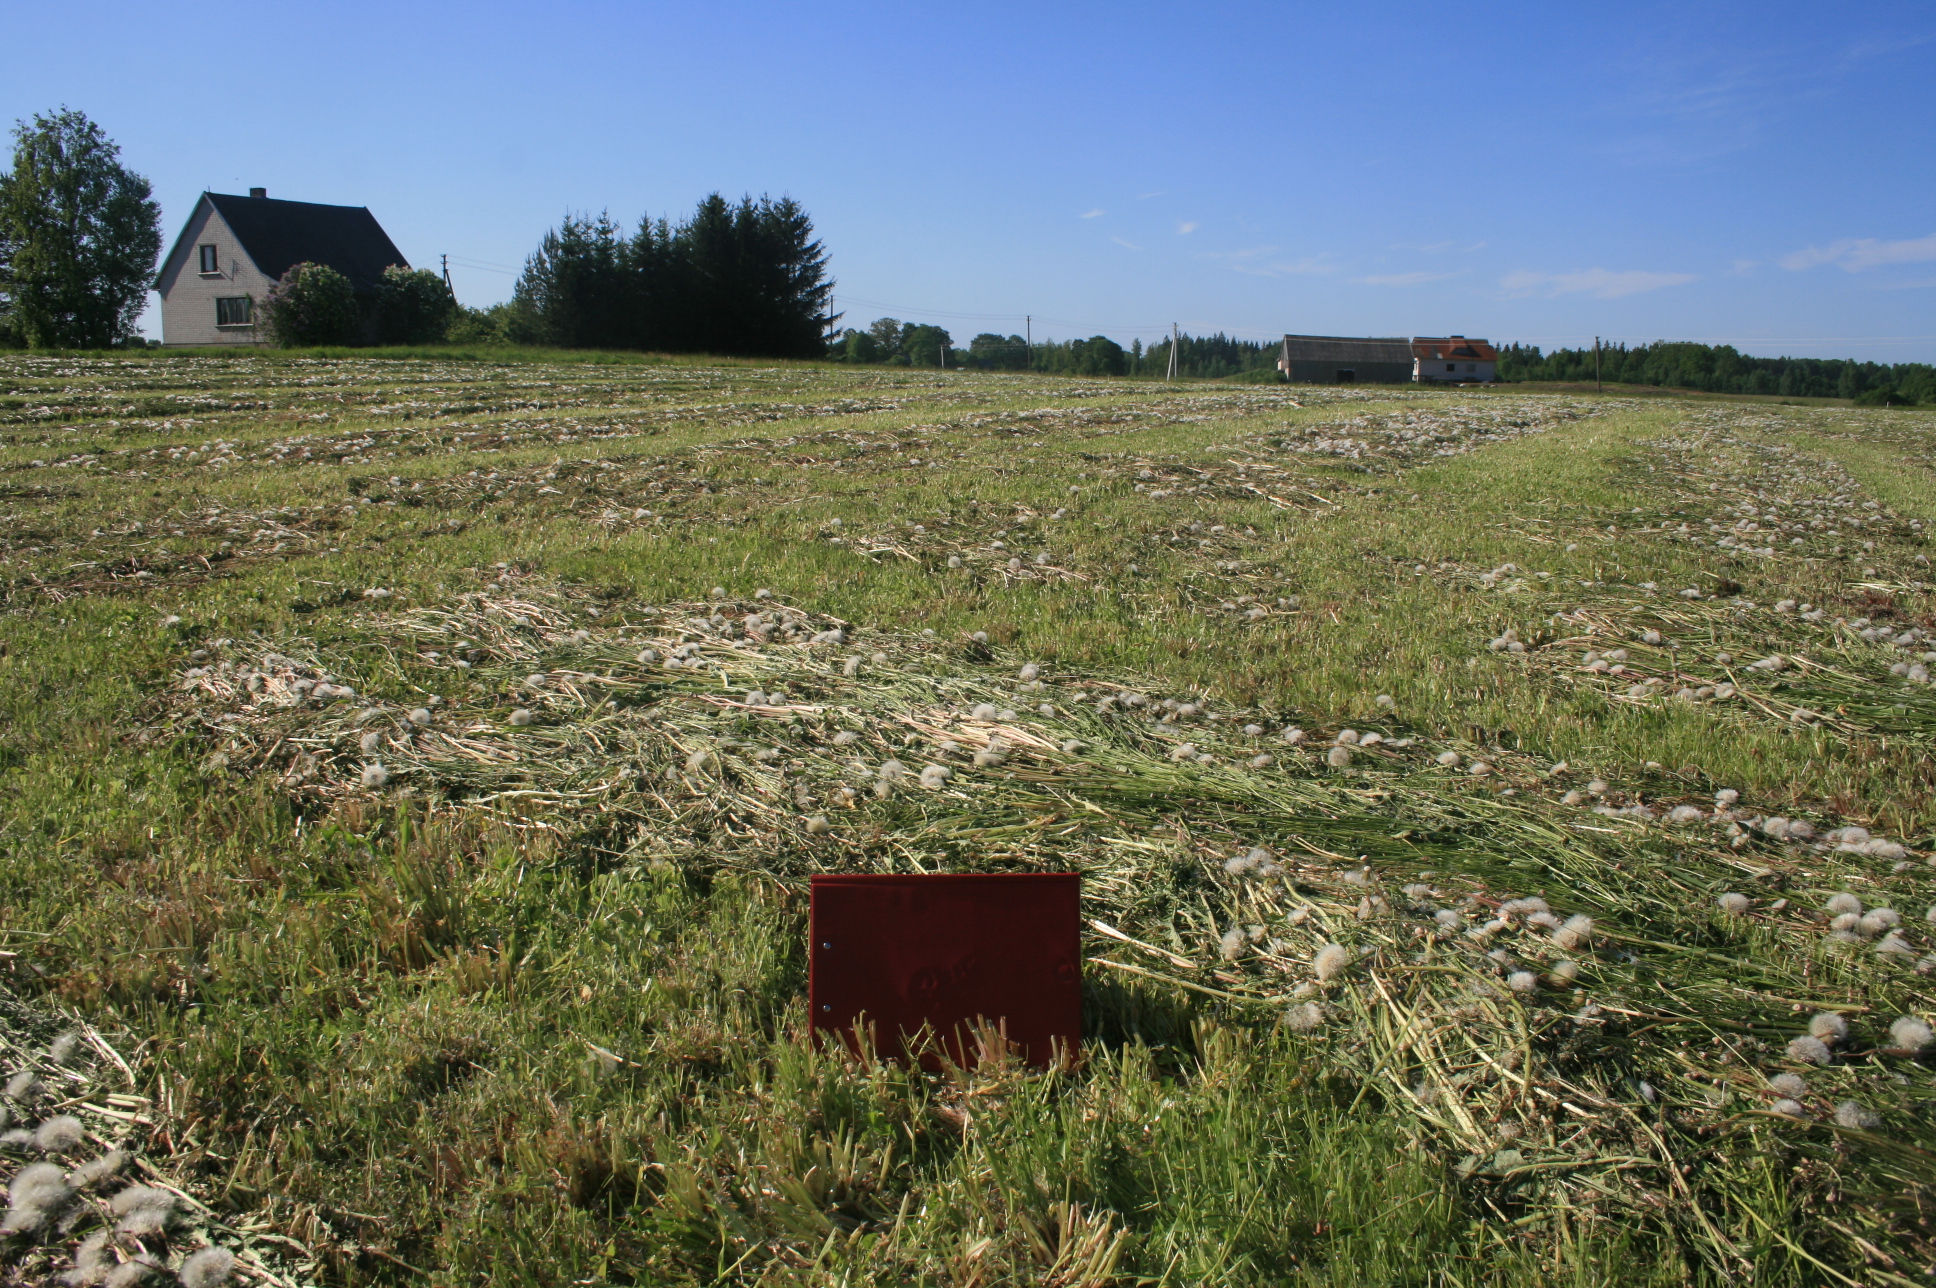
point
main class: Grassland
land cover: Grassland without tree/shrub cover
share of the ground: > 75 %
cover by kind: herbaceous plants 100 %
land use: Agriculture (excluding fallow land and kitchen gardens)
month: June
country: LT
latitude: 55.8777
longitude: 21.9919
